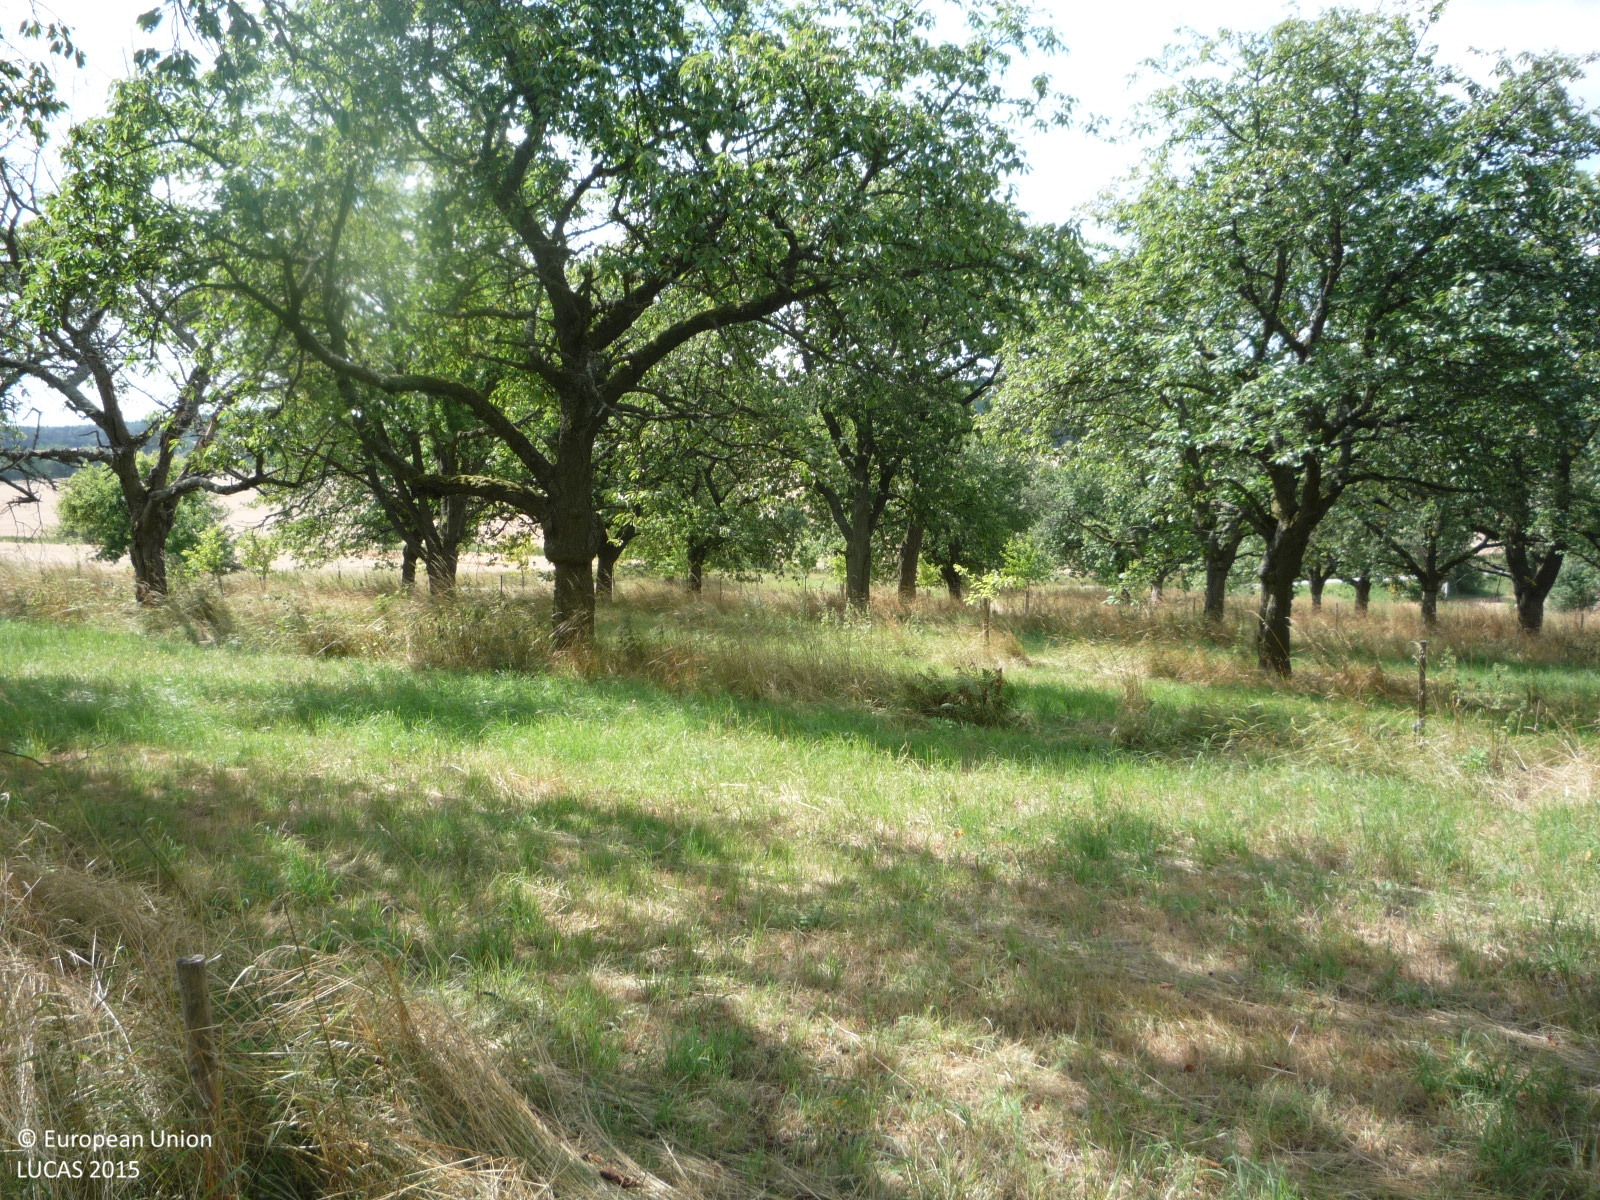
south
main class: Cropland
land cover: Cherry fruit
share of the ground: 50 - 75 %
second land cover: Grassland without tree/shrub cover
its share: 25 - 50 %
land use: Agriculture (excluding fallow land and kitchen gardens)
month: July
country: CZ
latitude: 50.4978
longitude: 15.2054
